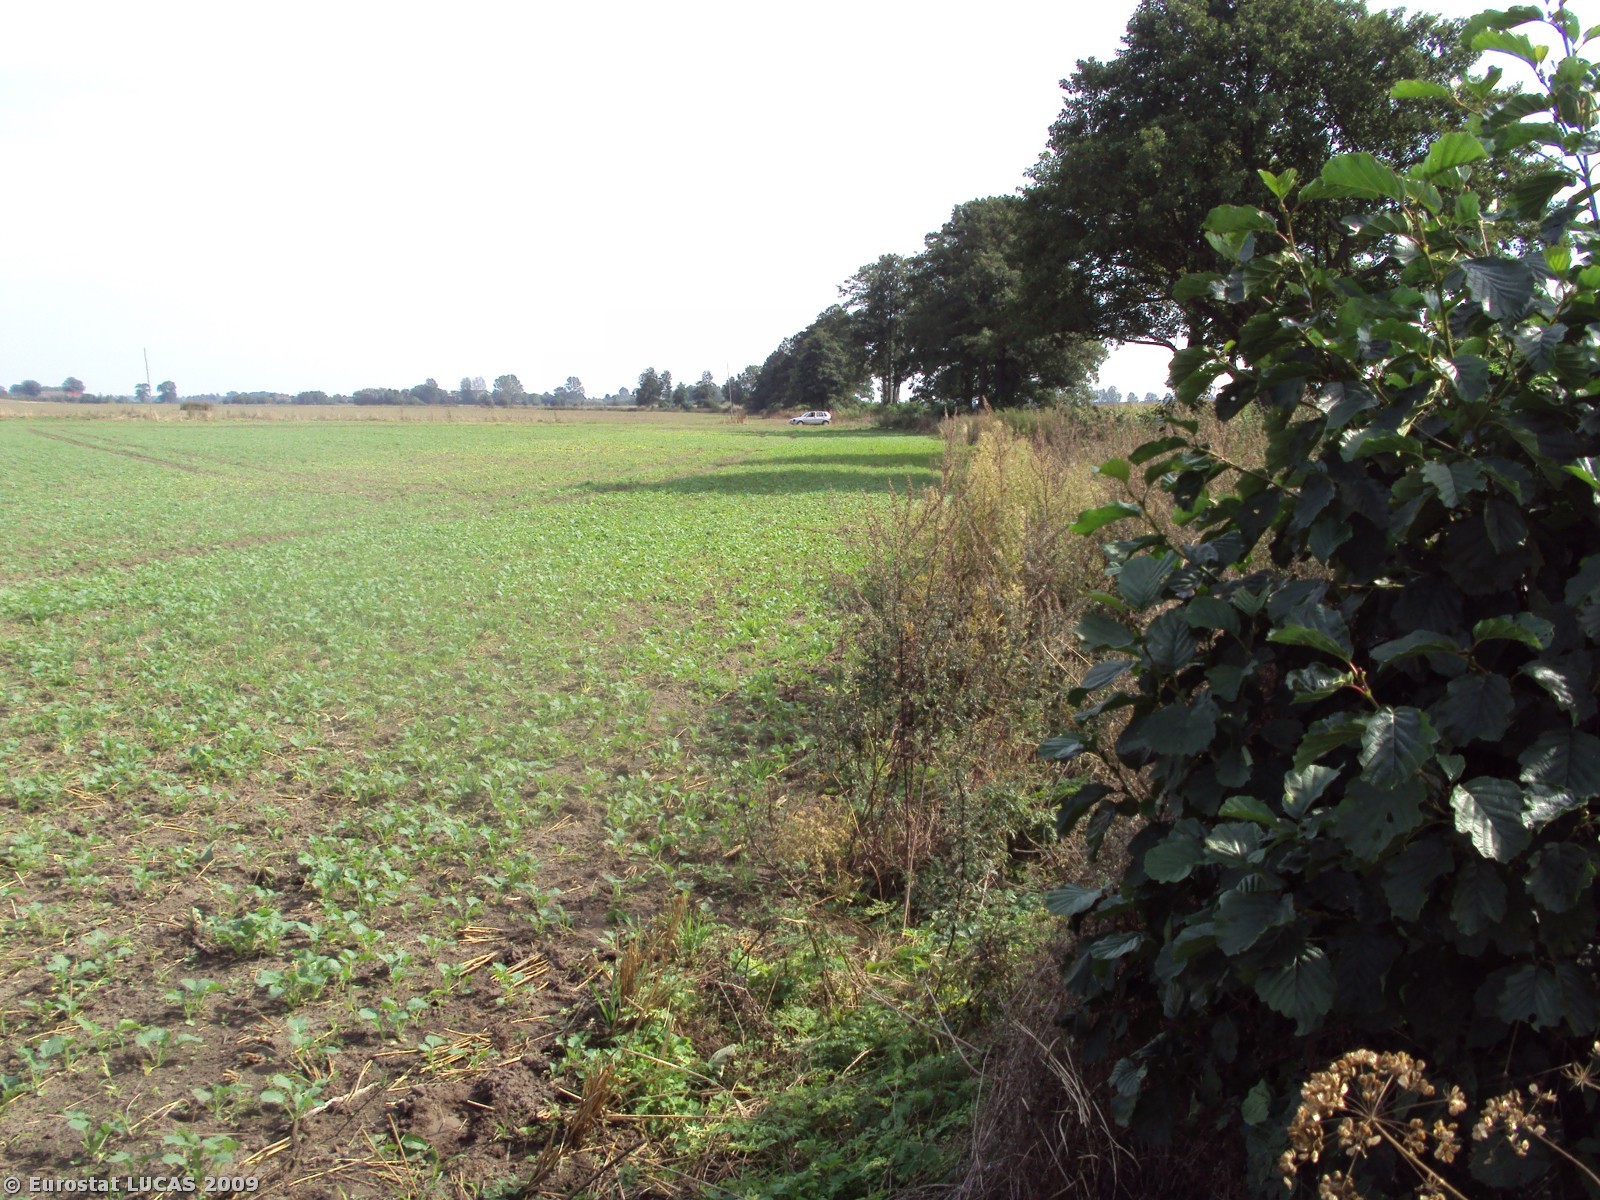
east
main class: Cropland
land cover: Maize
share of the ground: > 75 %
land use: Agriculture (excluding fallow land and kitchen gardens)
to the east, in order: Maize; Tracks; Maize
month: September
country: PL
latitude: 53.4570
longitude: 16.5885
